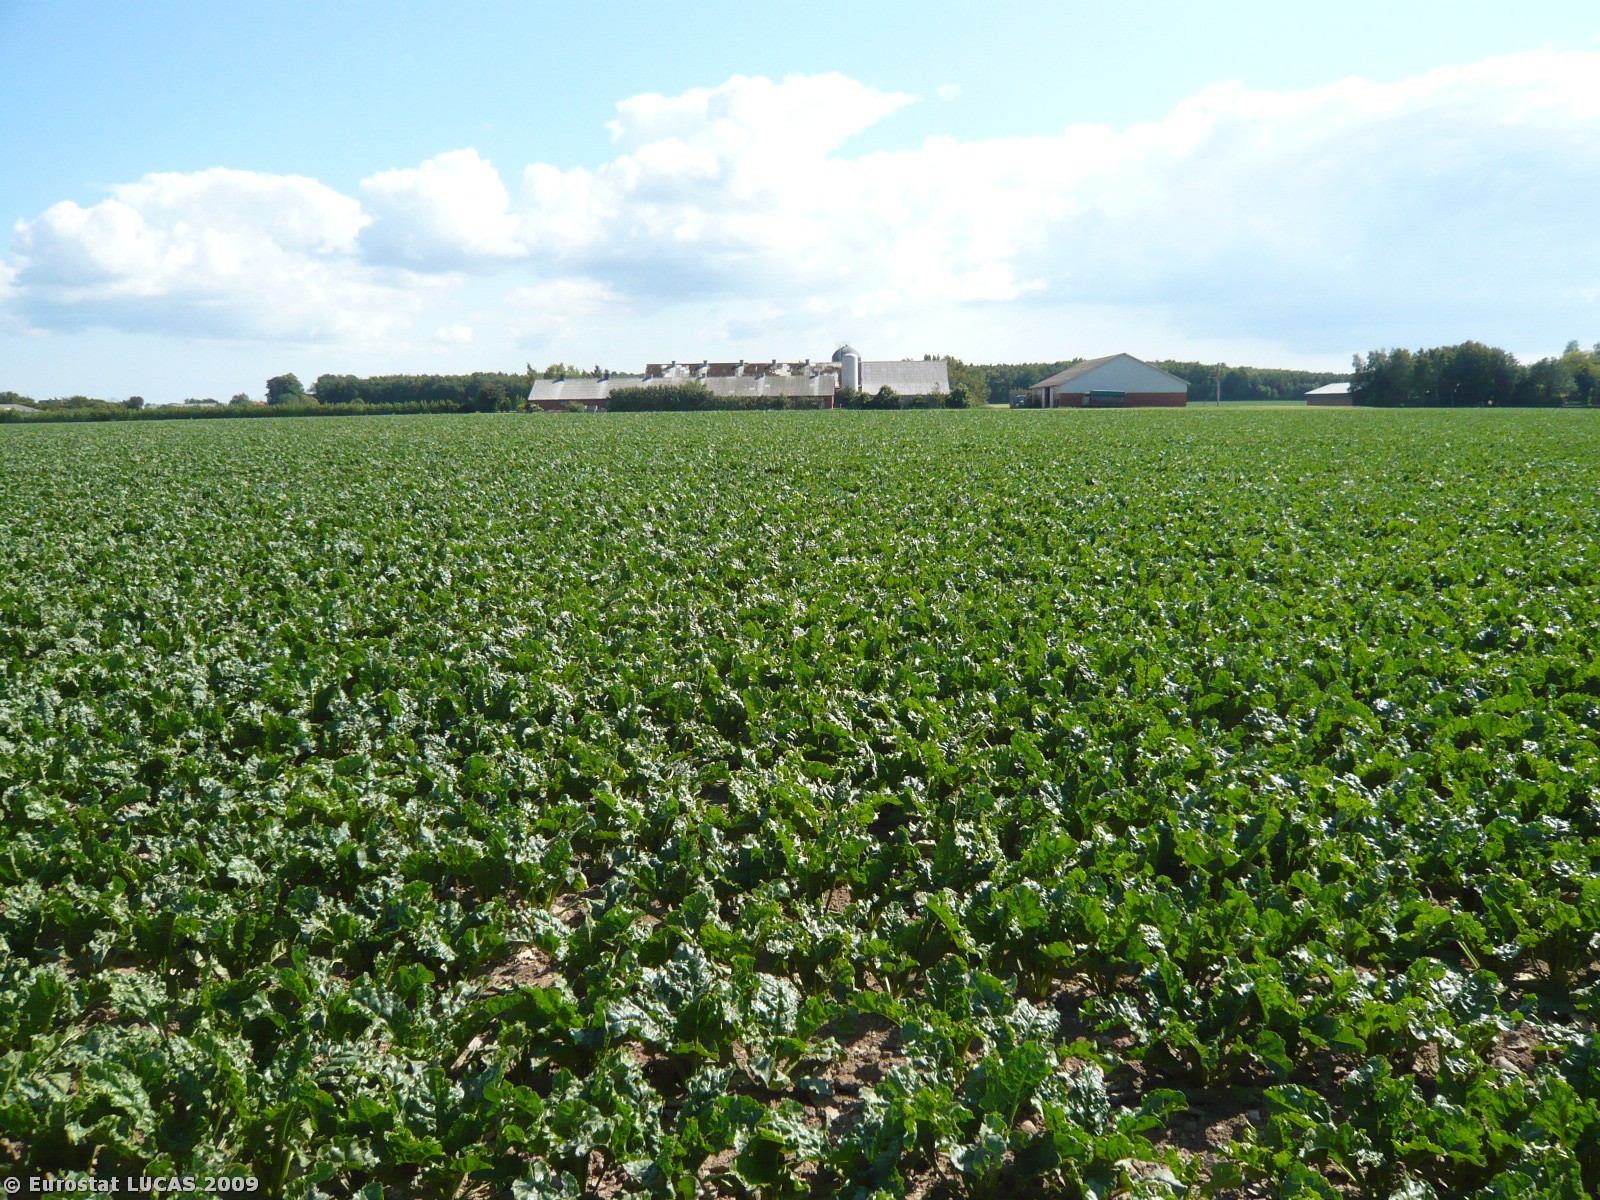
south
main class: Cropland
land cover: Sugar beet
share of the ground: > 75 %
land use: Agriculture (excluding fallow land and kitchen gardens)
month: June
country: DK
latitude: 54.8825
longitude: 11.6667
